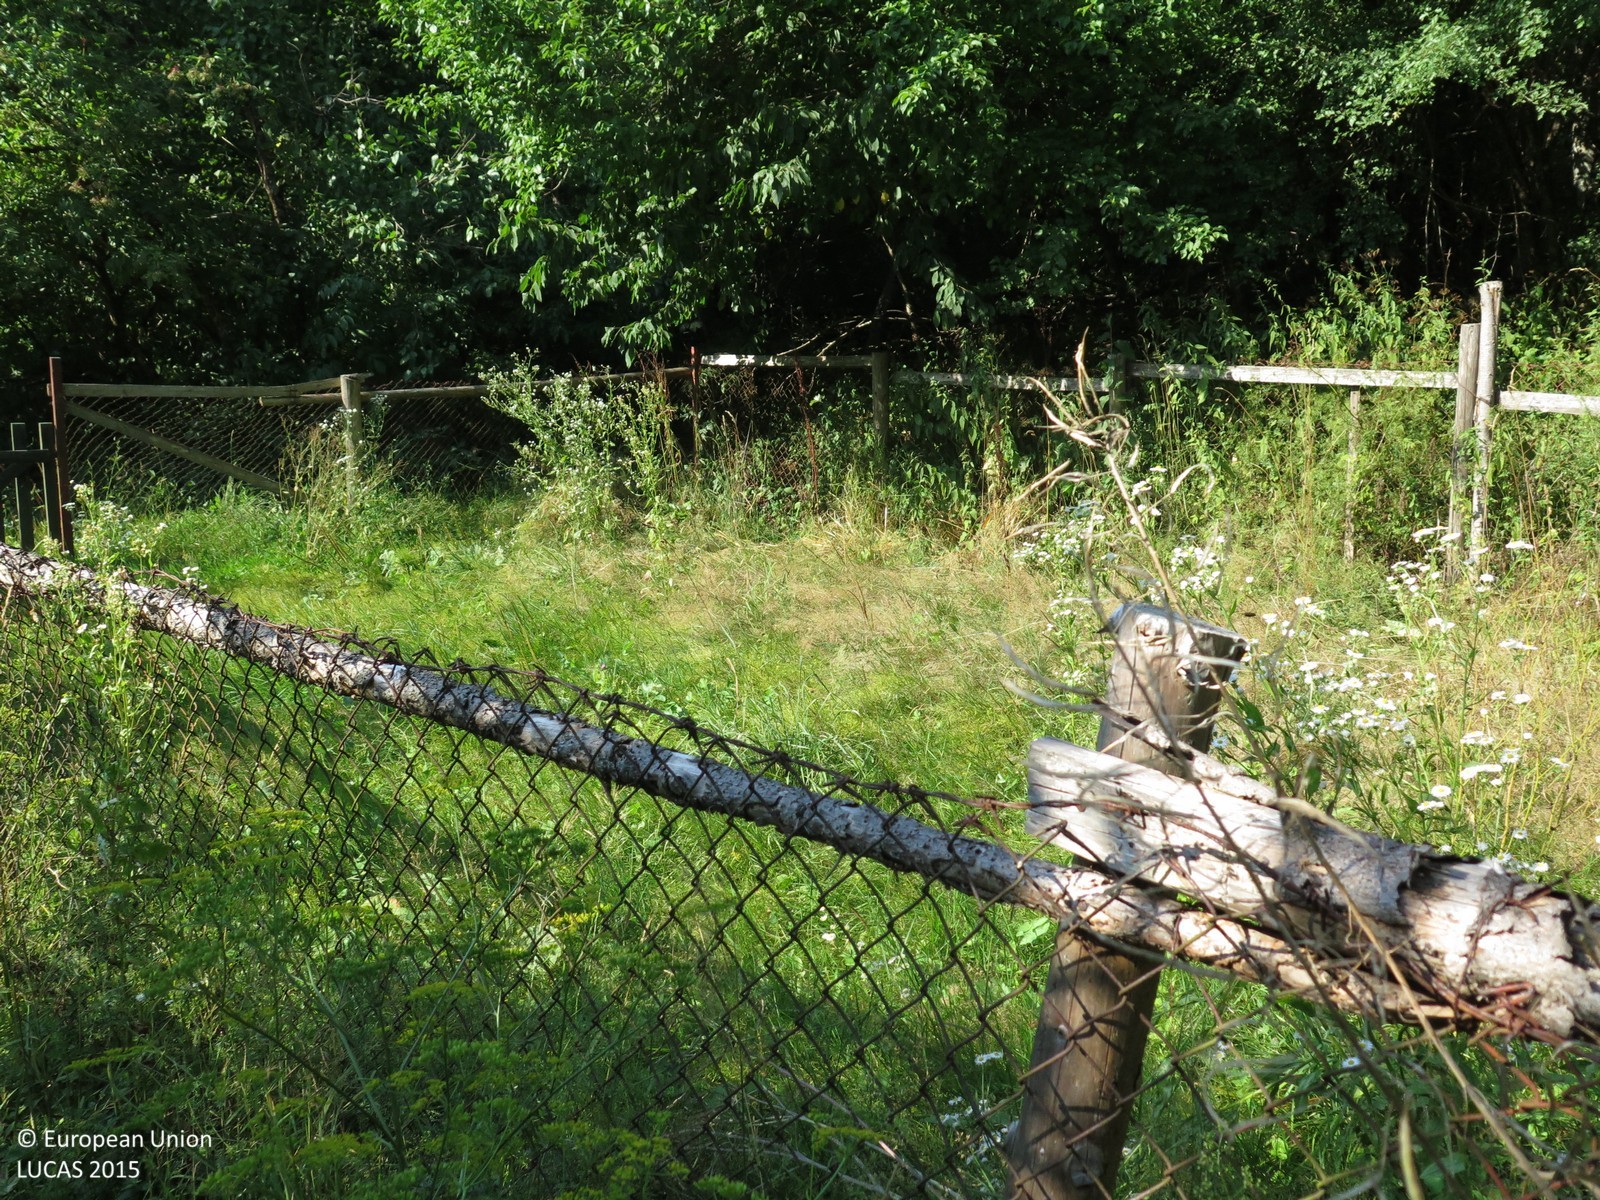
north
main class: Grassland
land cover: Grassland with sparse tree/shrub cover
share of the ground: > 75 %
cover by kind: herbaceous plants 90 %, broadleaved forest trees 5 %, shrubs 5 %
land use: Semi-natural and natural areas not in use
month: August
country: HR
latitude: 45.3274
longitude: 14.7030
